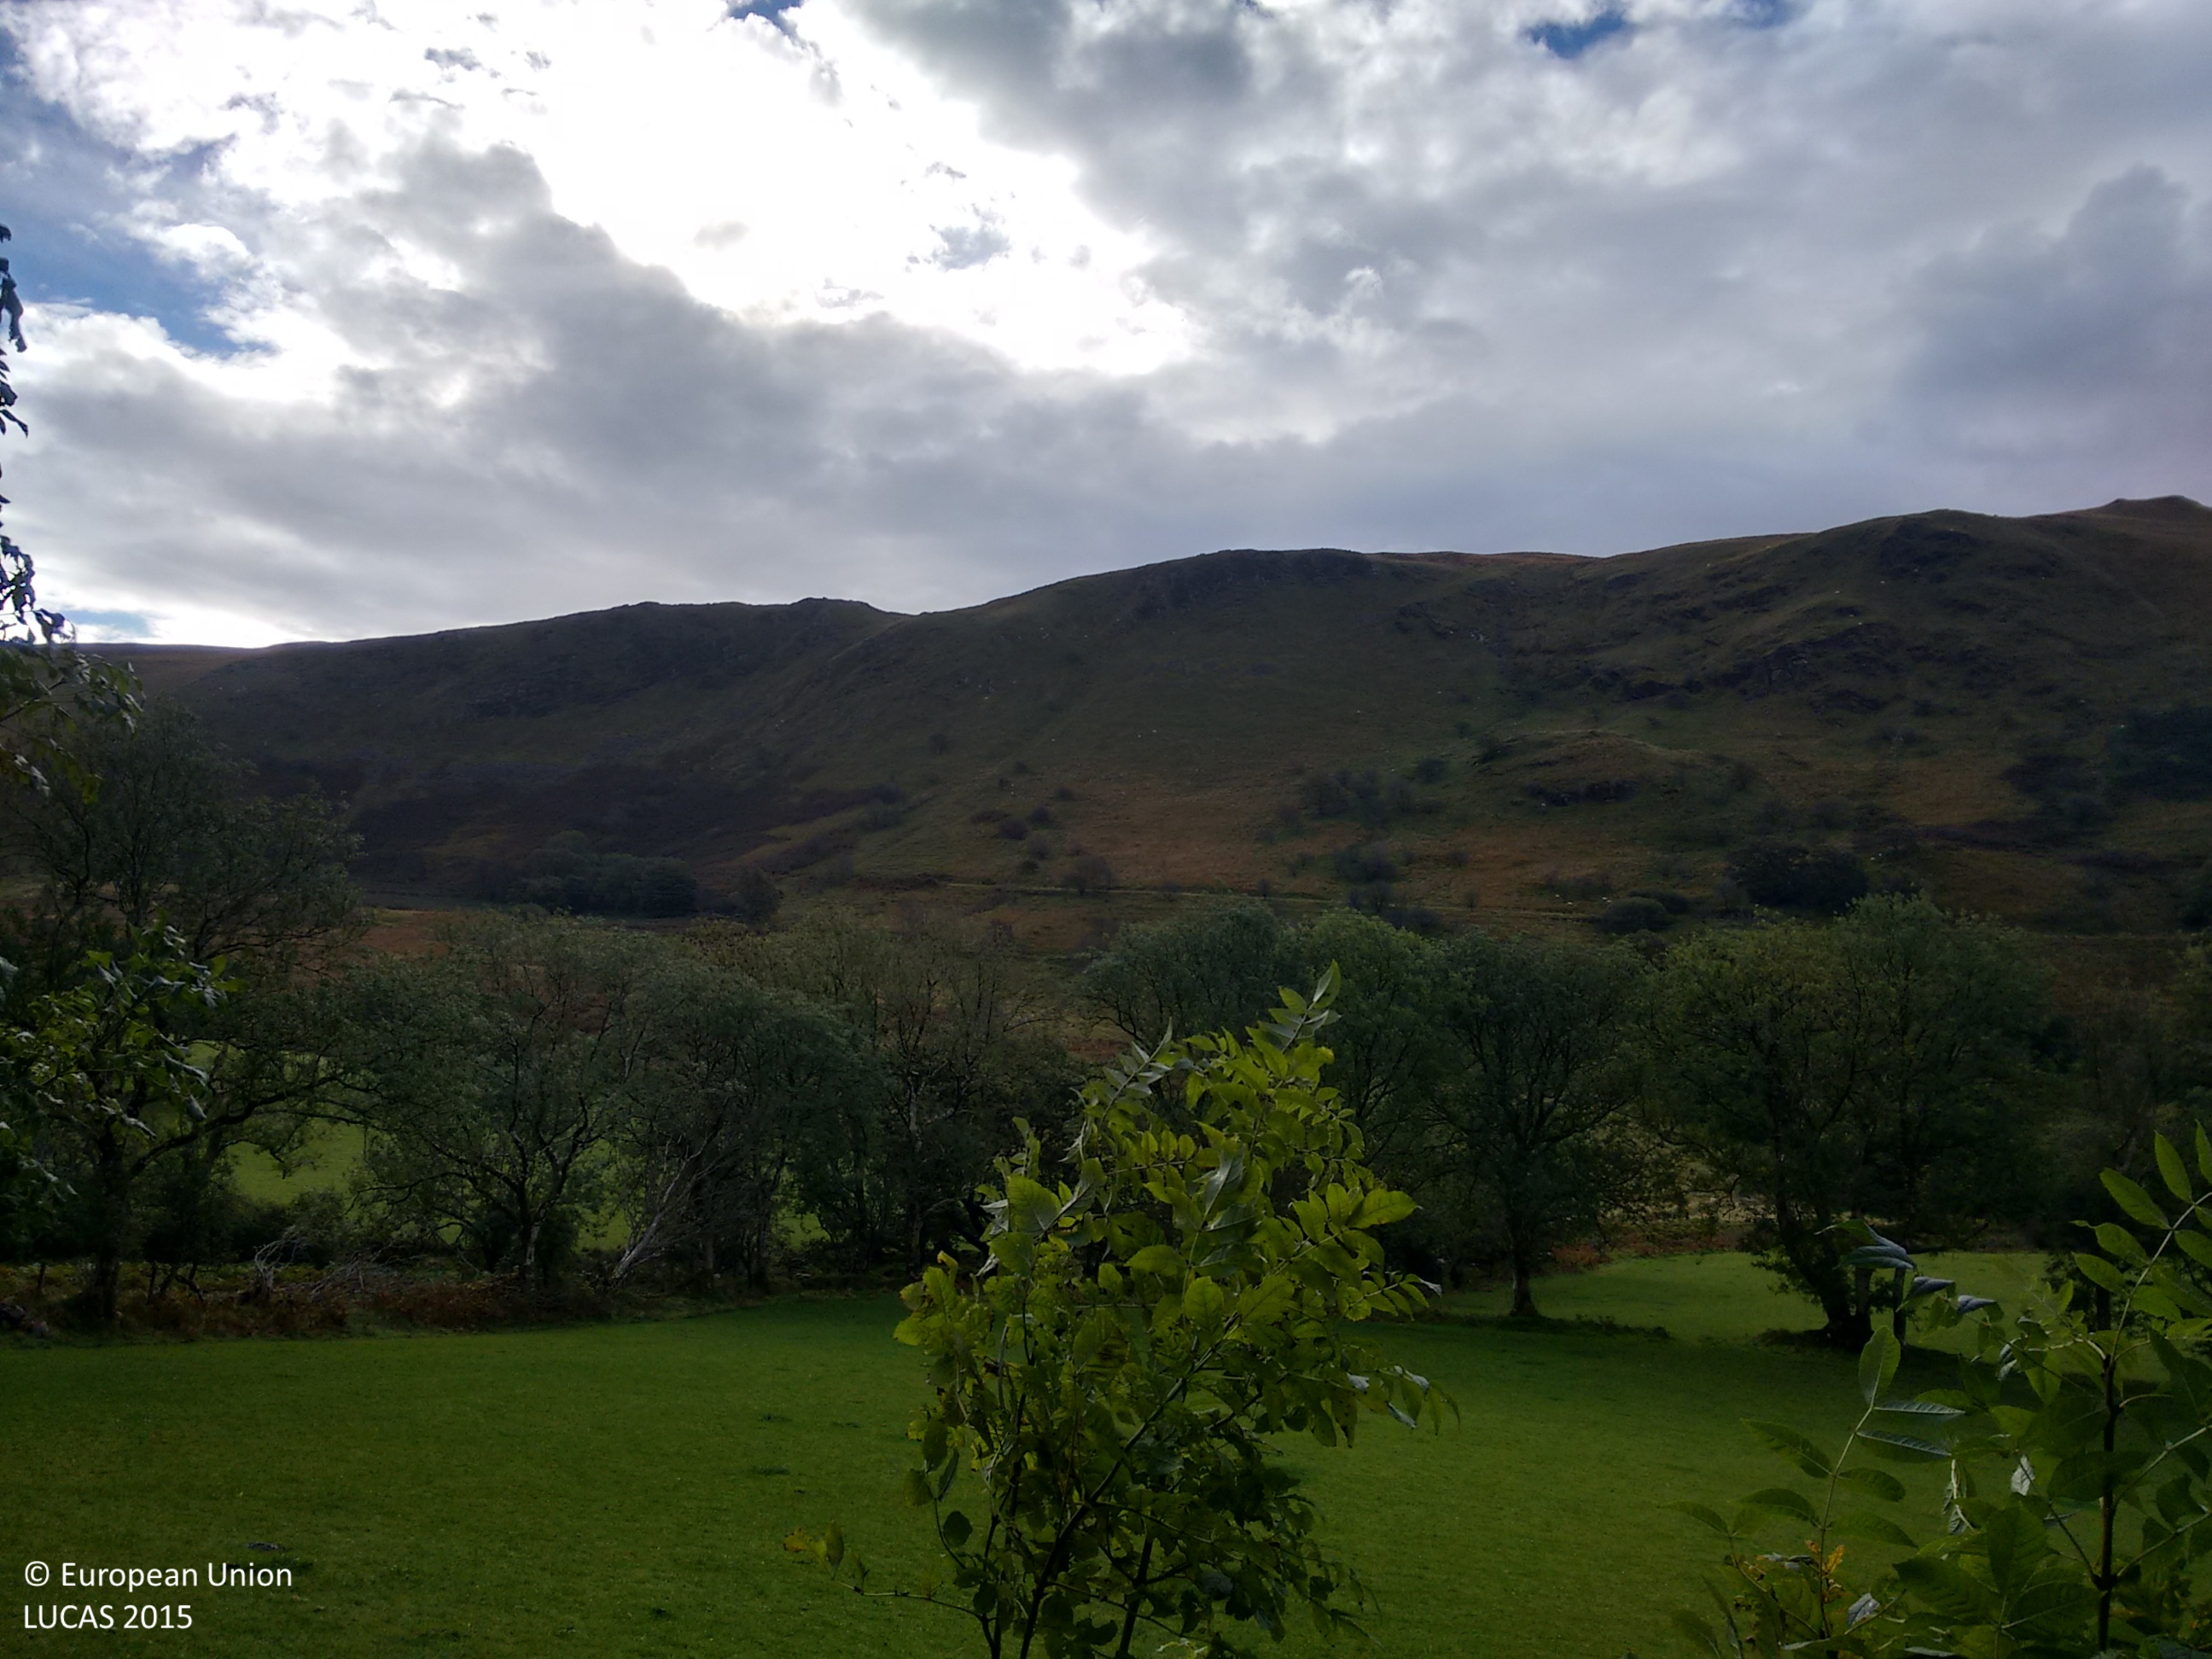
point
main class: Shrubland
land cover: Shrubland without tree cover
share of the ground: > 75 %
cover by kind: shrubs 100 %
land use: Semi-natural and natural areas not in use
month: October
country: GB
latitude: 52.4689
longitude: -3.8851
